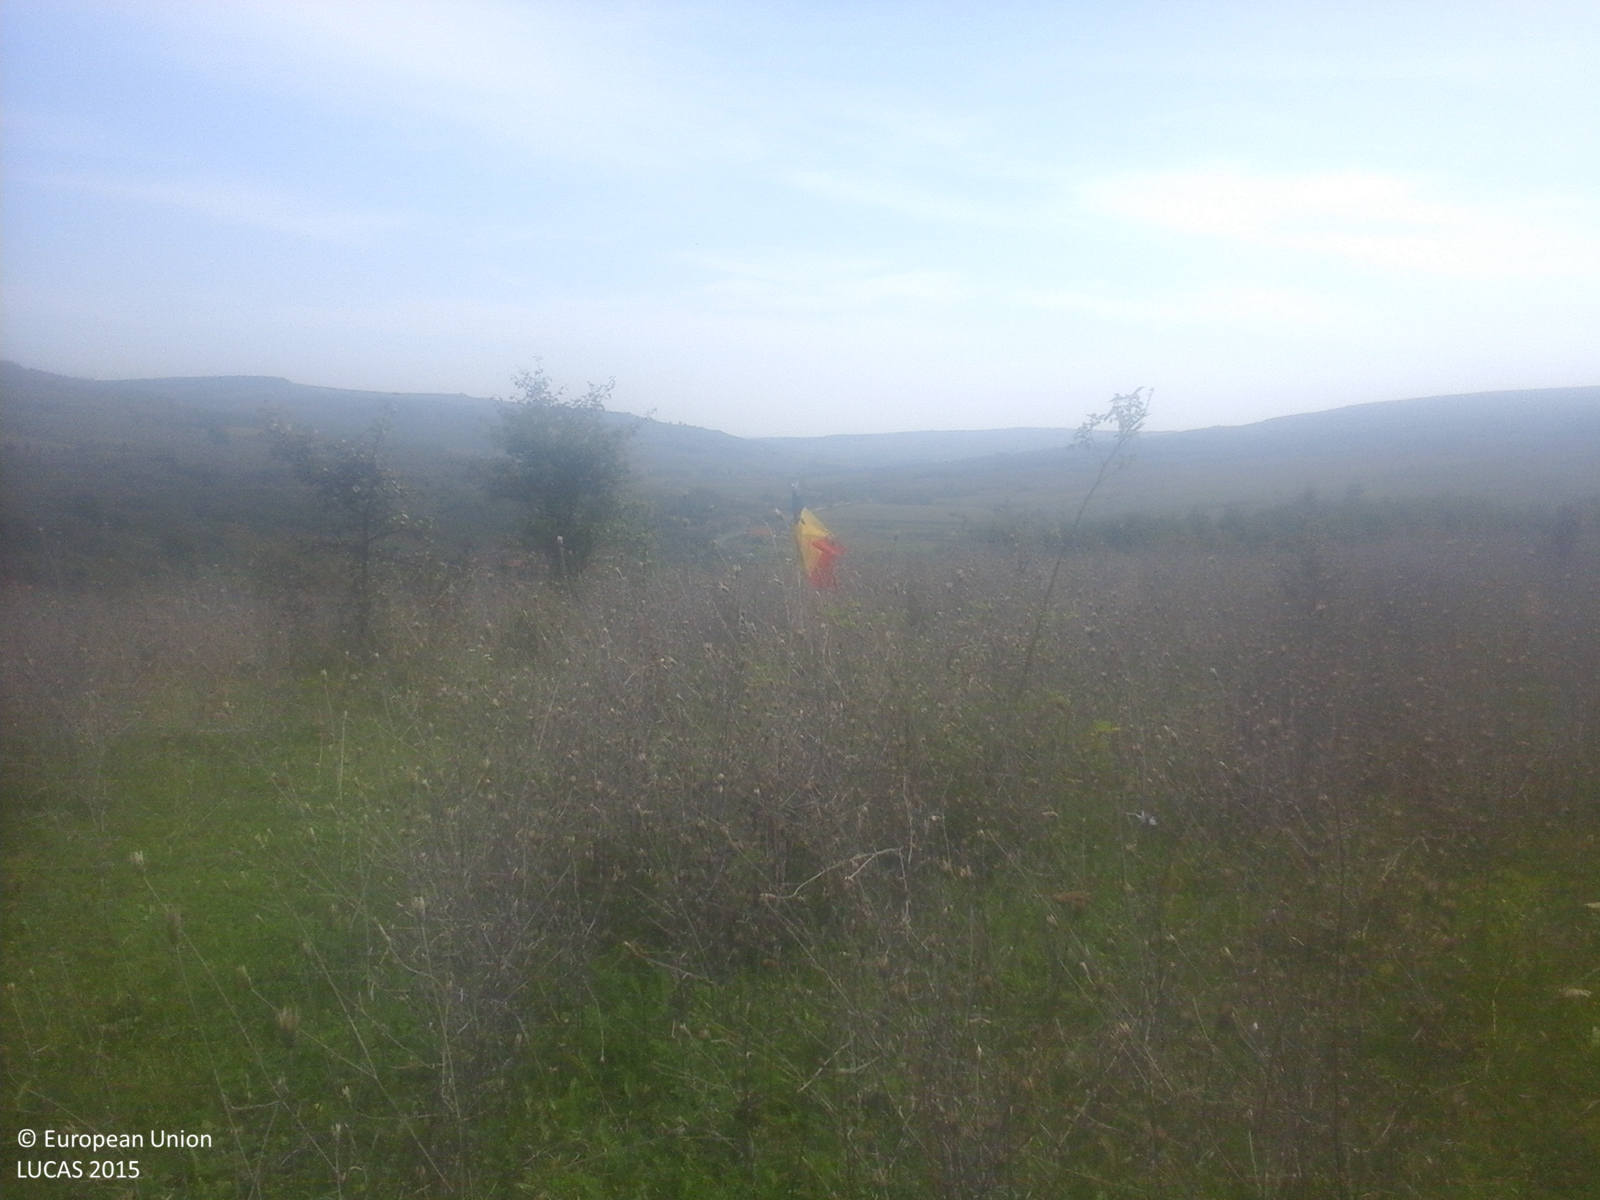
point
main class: Shrubland
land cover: Shrubland without tree cover
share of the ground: > 75 %
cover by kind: herbaceous plants 75 %, shrubs 25 %
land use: Agriculture (excluding fallow land and kitchen gardens)
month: September
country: RO
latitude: 47.0000
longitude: 23.6856
